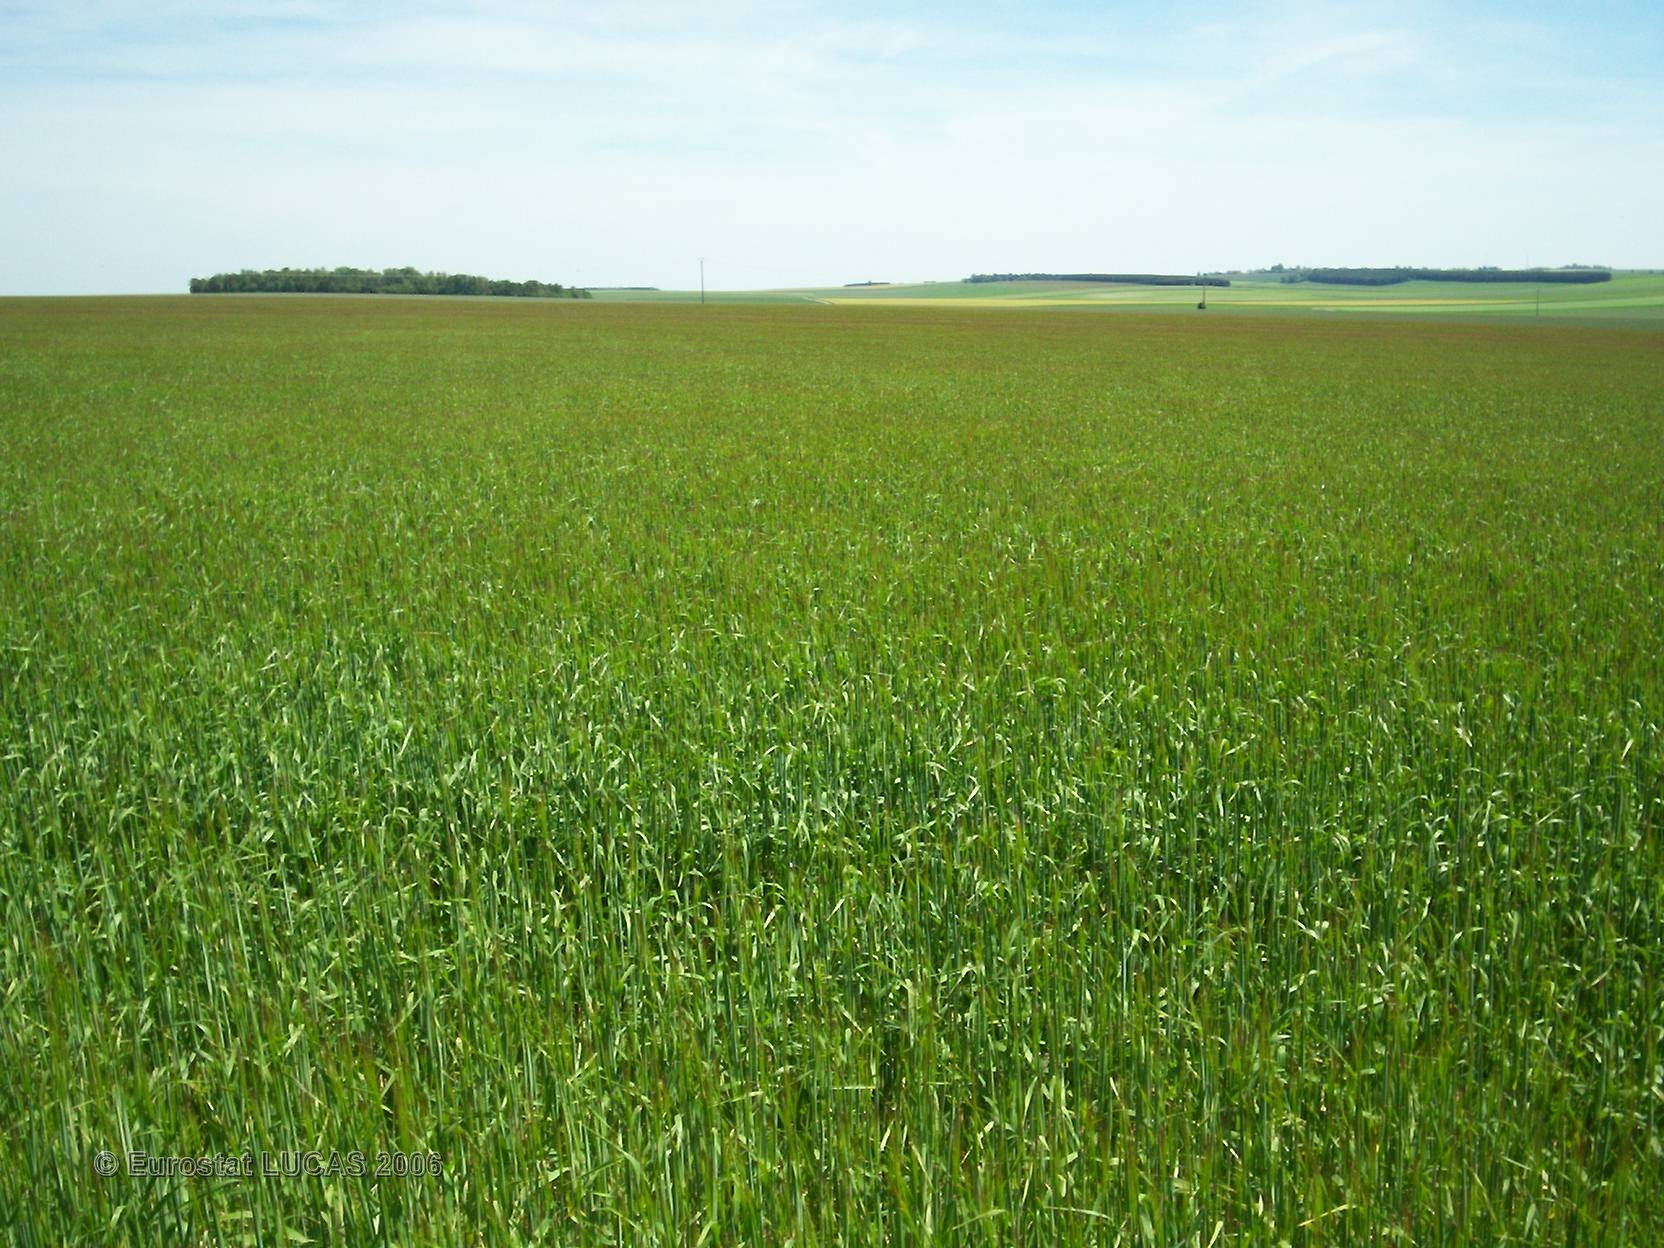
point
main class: Cropland
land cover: Barley
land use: Agriculture (excluding fallow land and kitchen gardens)
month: June
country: FR
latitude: 49.0645
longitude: 4.5906
